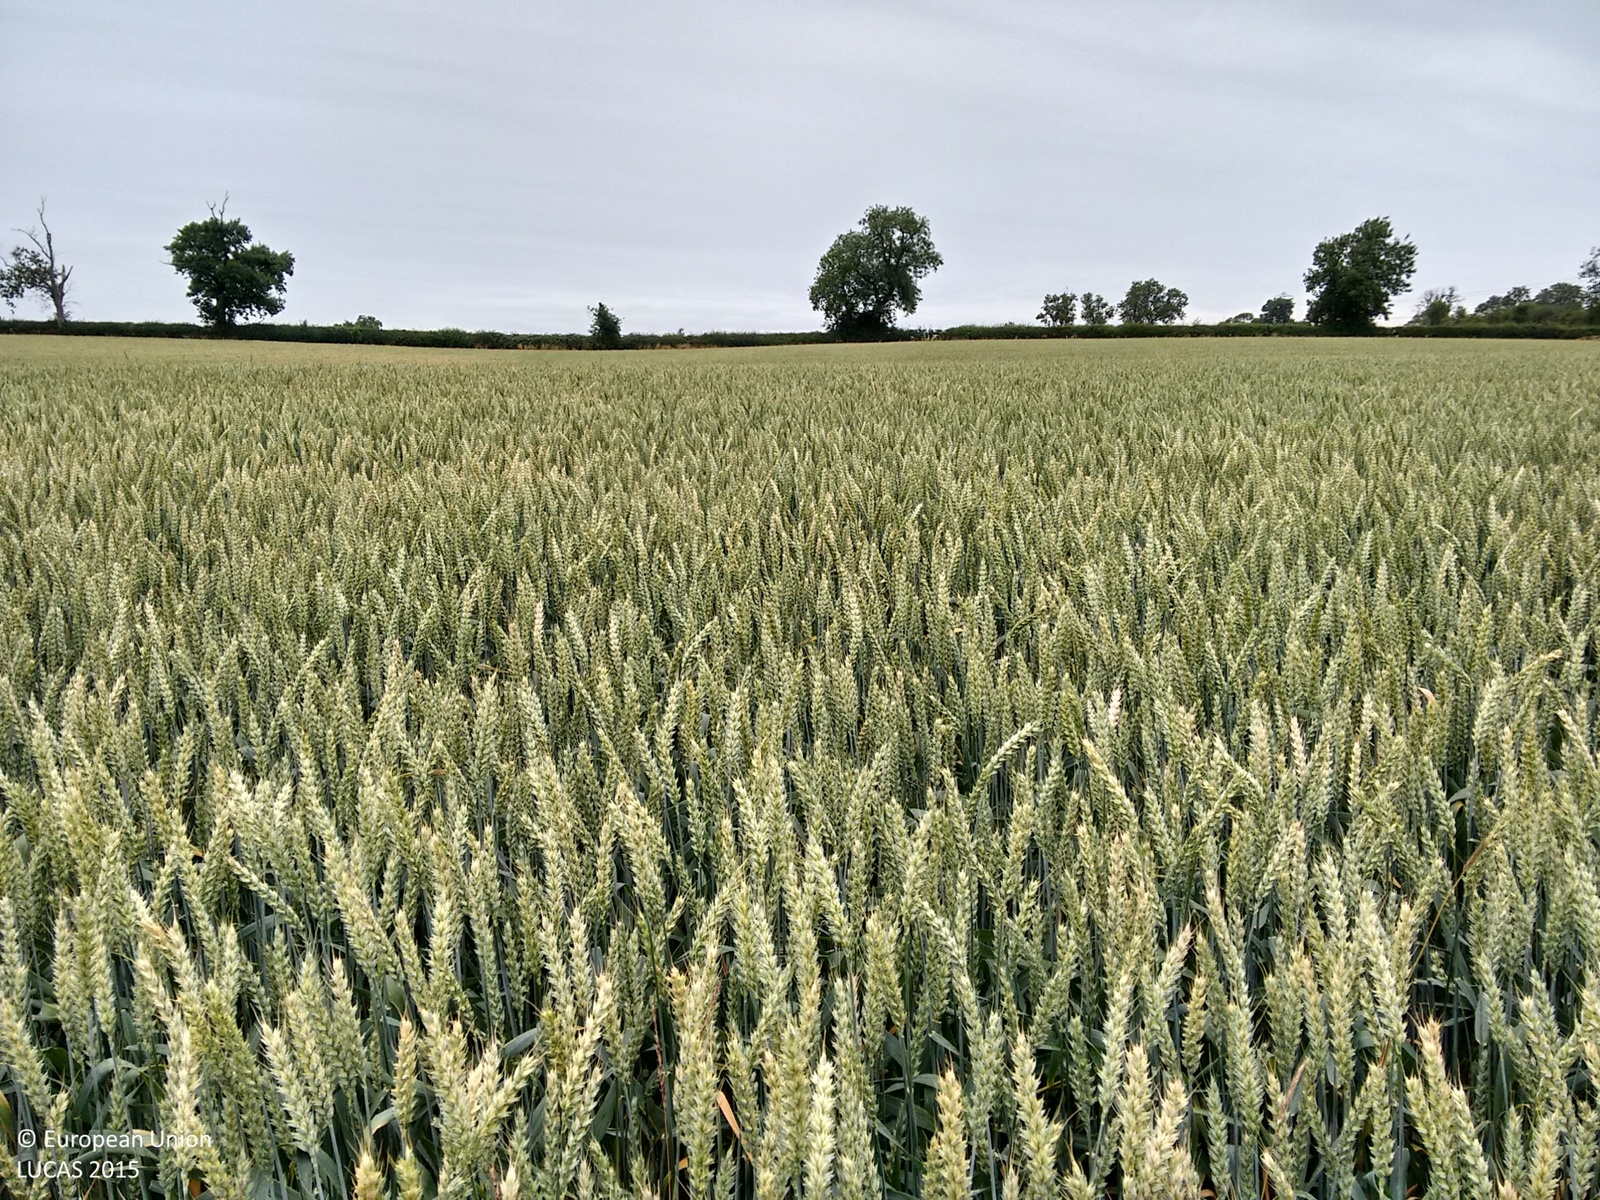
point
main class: Cropland
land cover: Common wheat
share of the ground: > 75 %
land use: Agriculture (excluding fallow land and kitchen gardens)
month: July
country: GB
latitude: 52.7395
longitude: -0.9596
